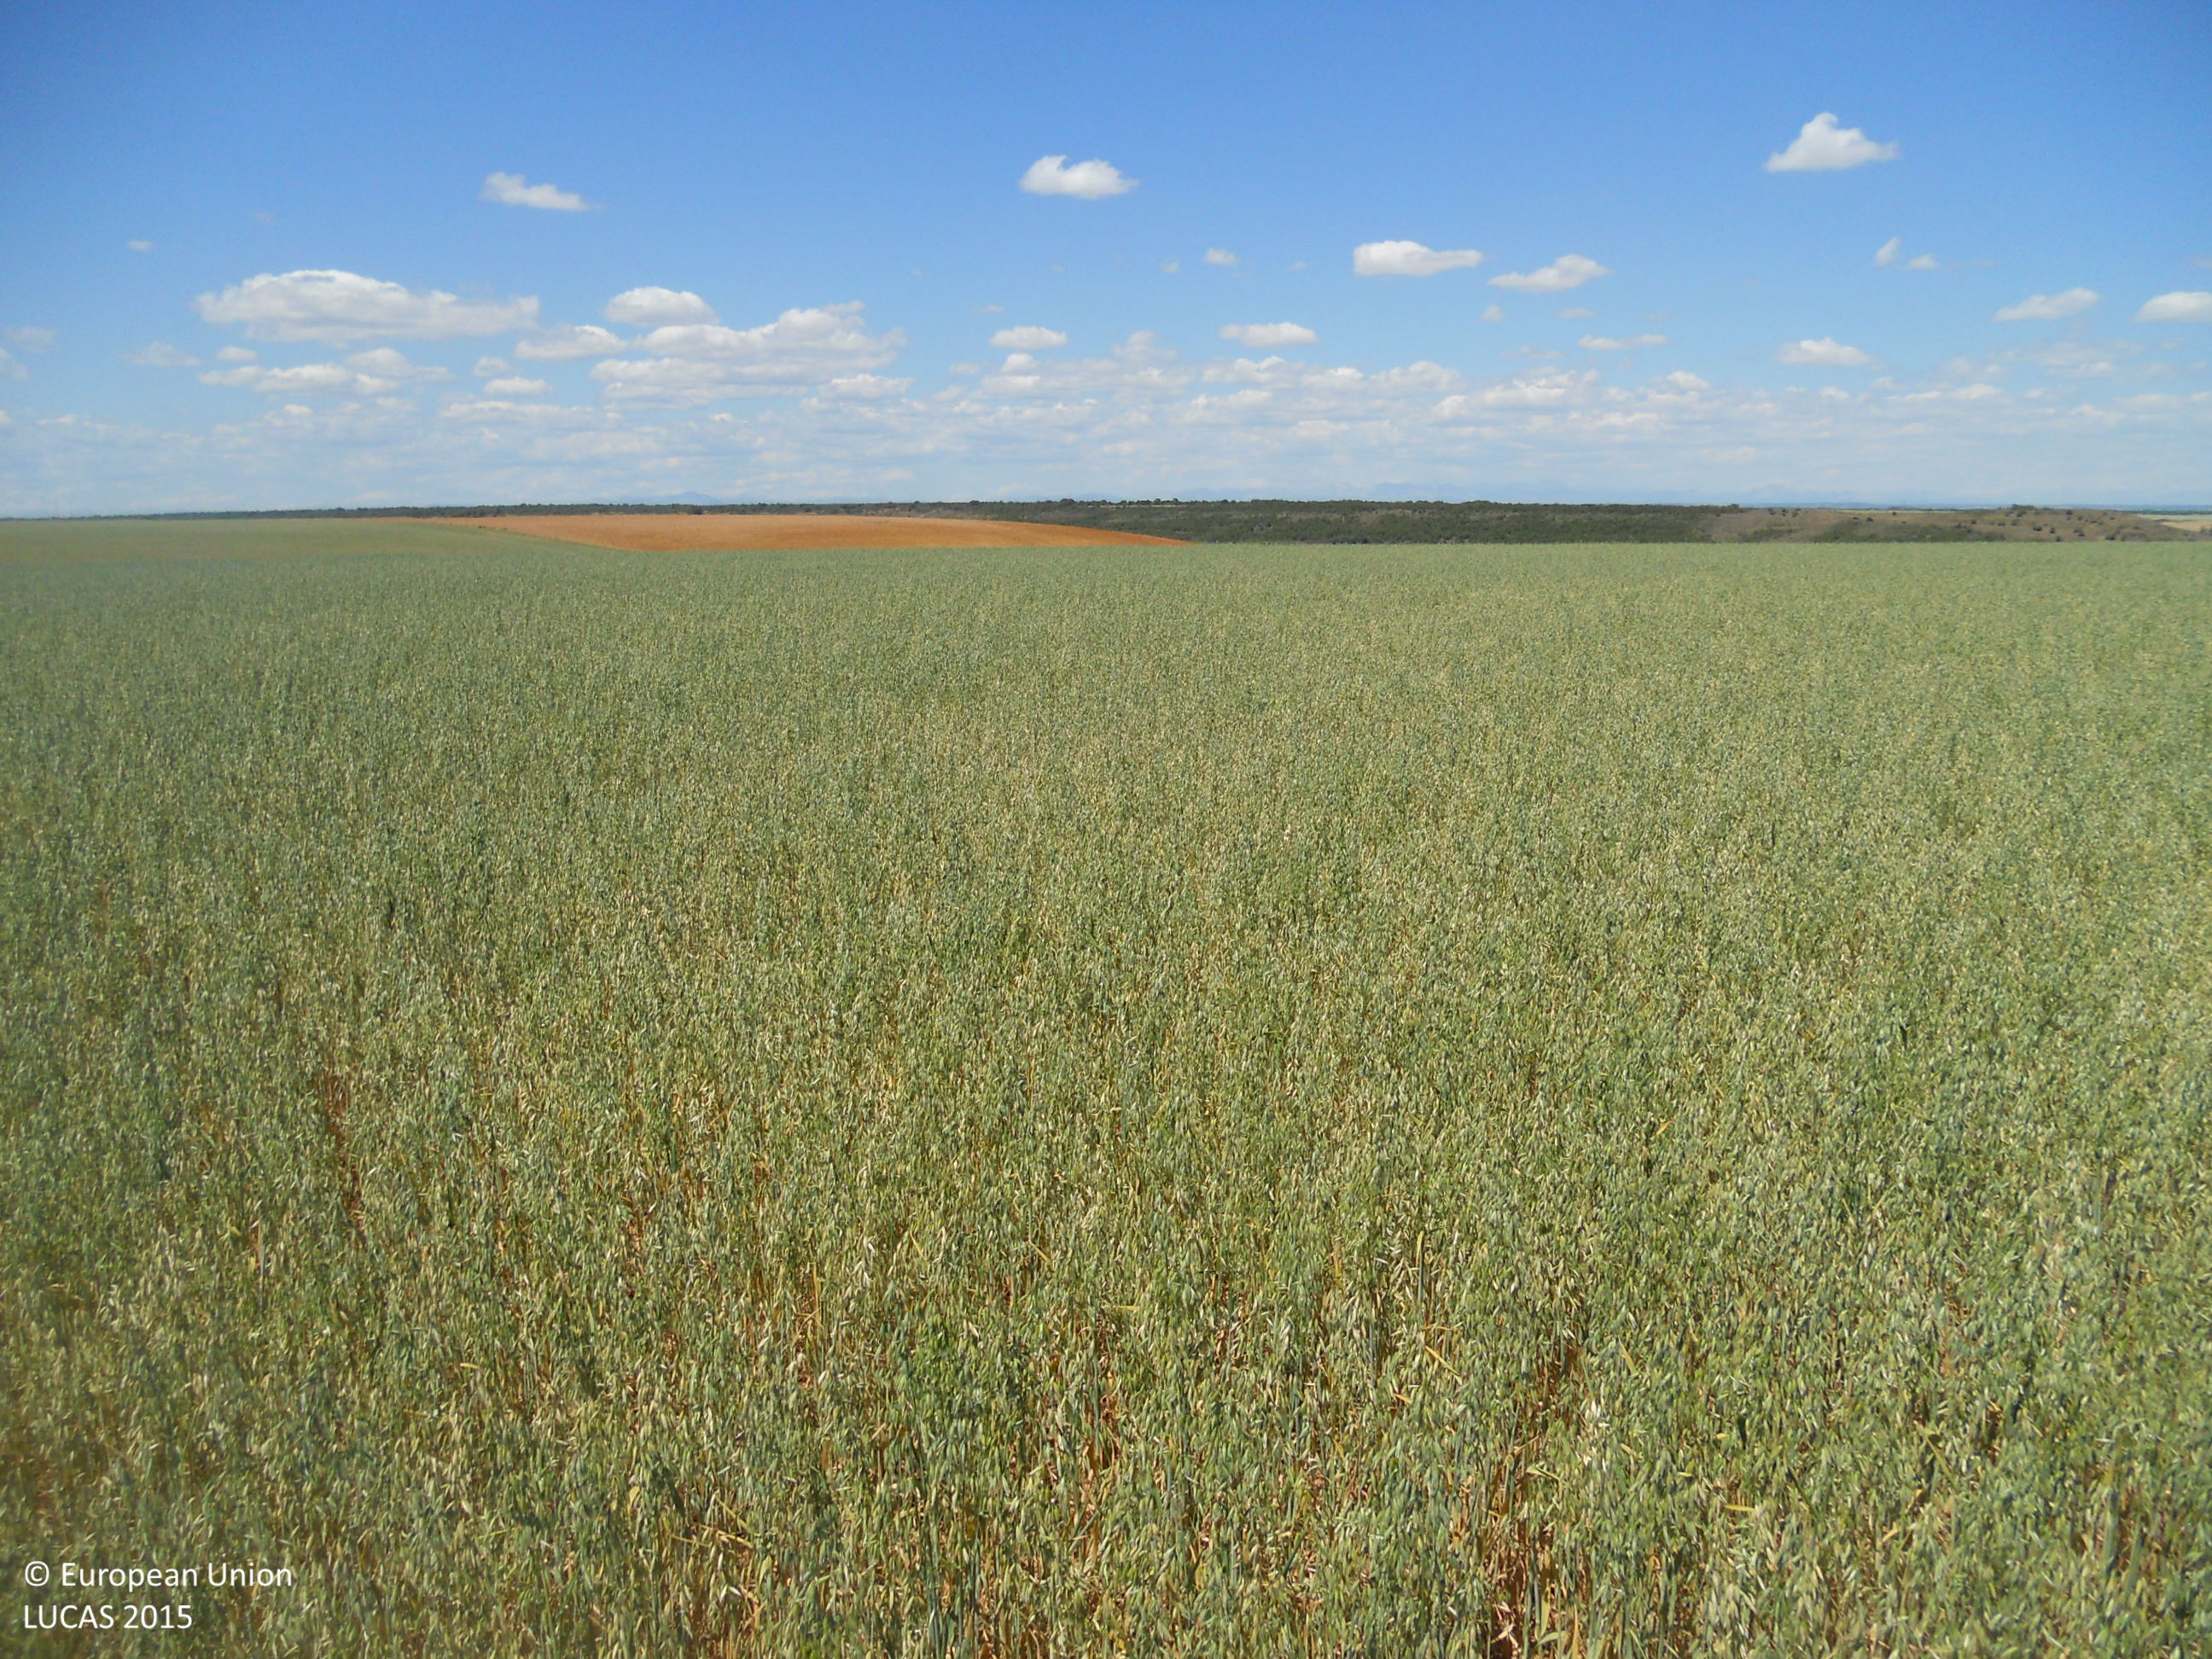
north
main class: Cropland
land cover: Oats
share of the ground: > 75 %
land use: Agriculture (excluding fallow land and kitchen gardens)
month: May
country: ES
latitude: 42.3086
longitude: -4.8187
